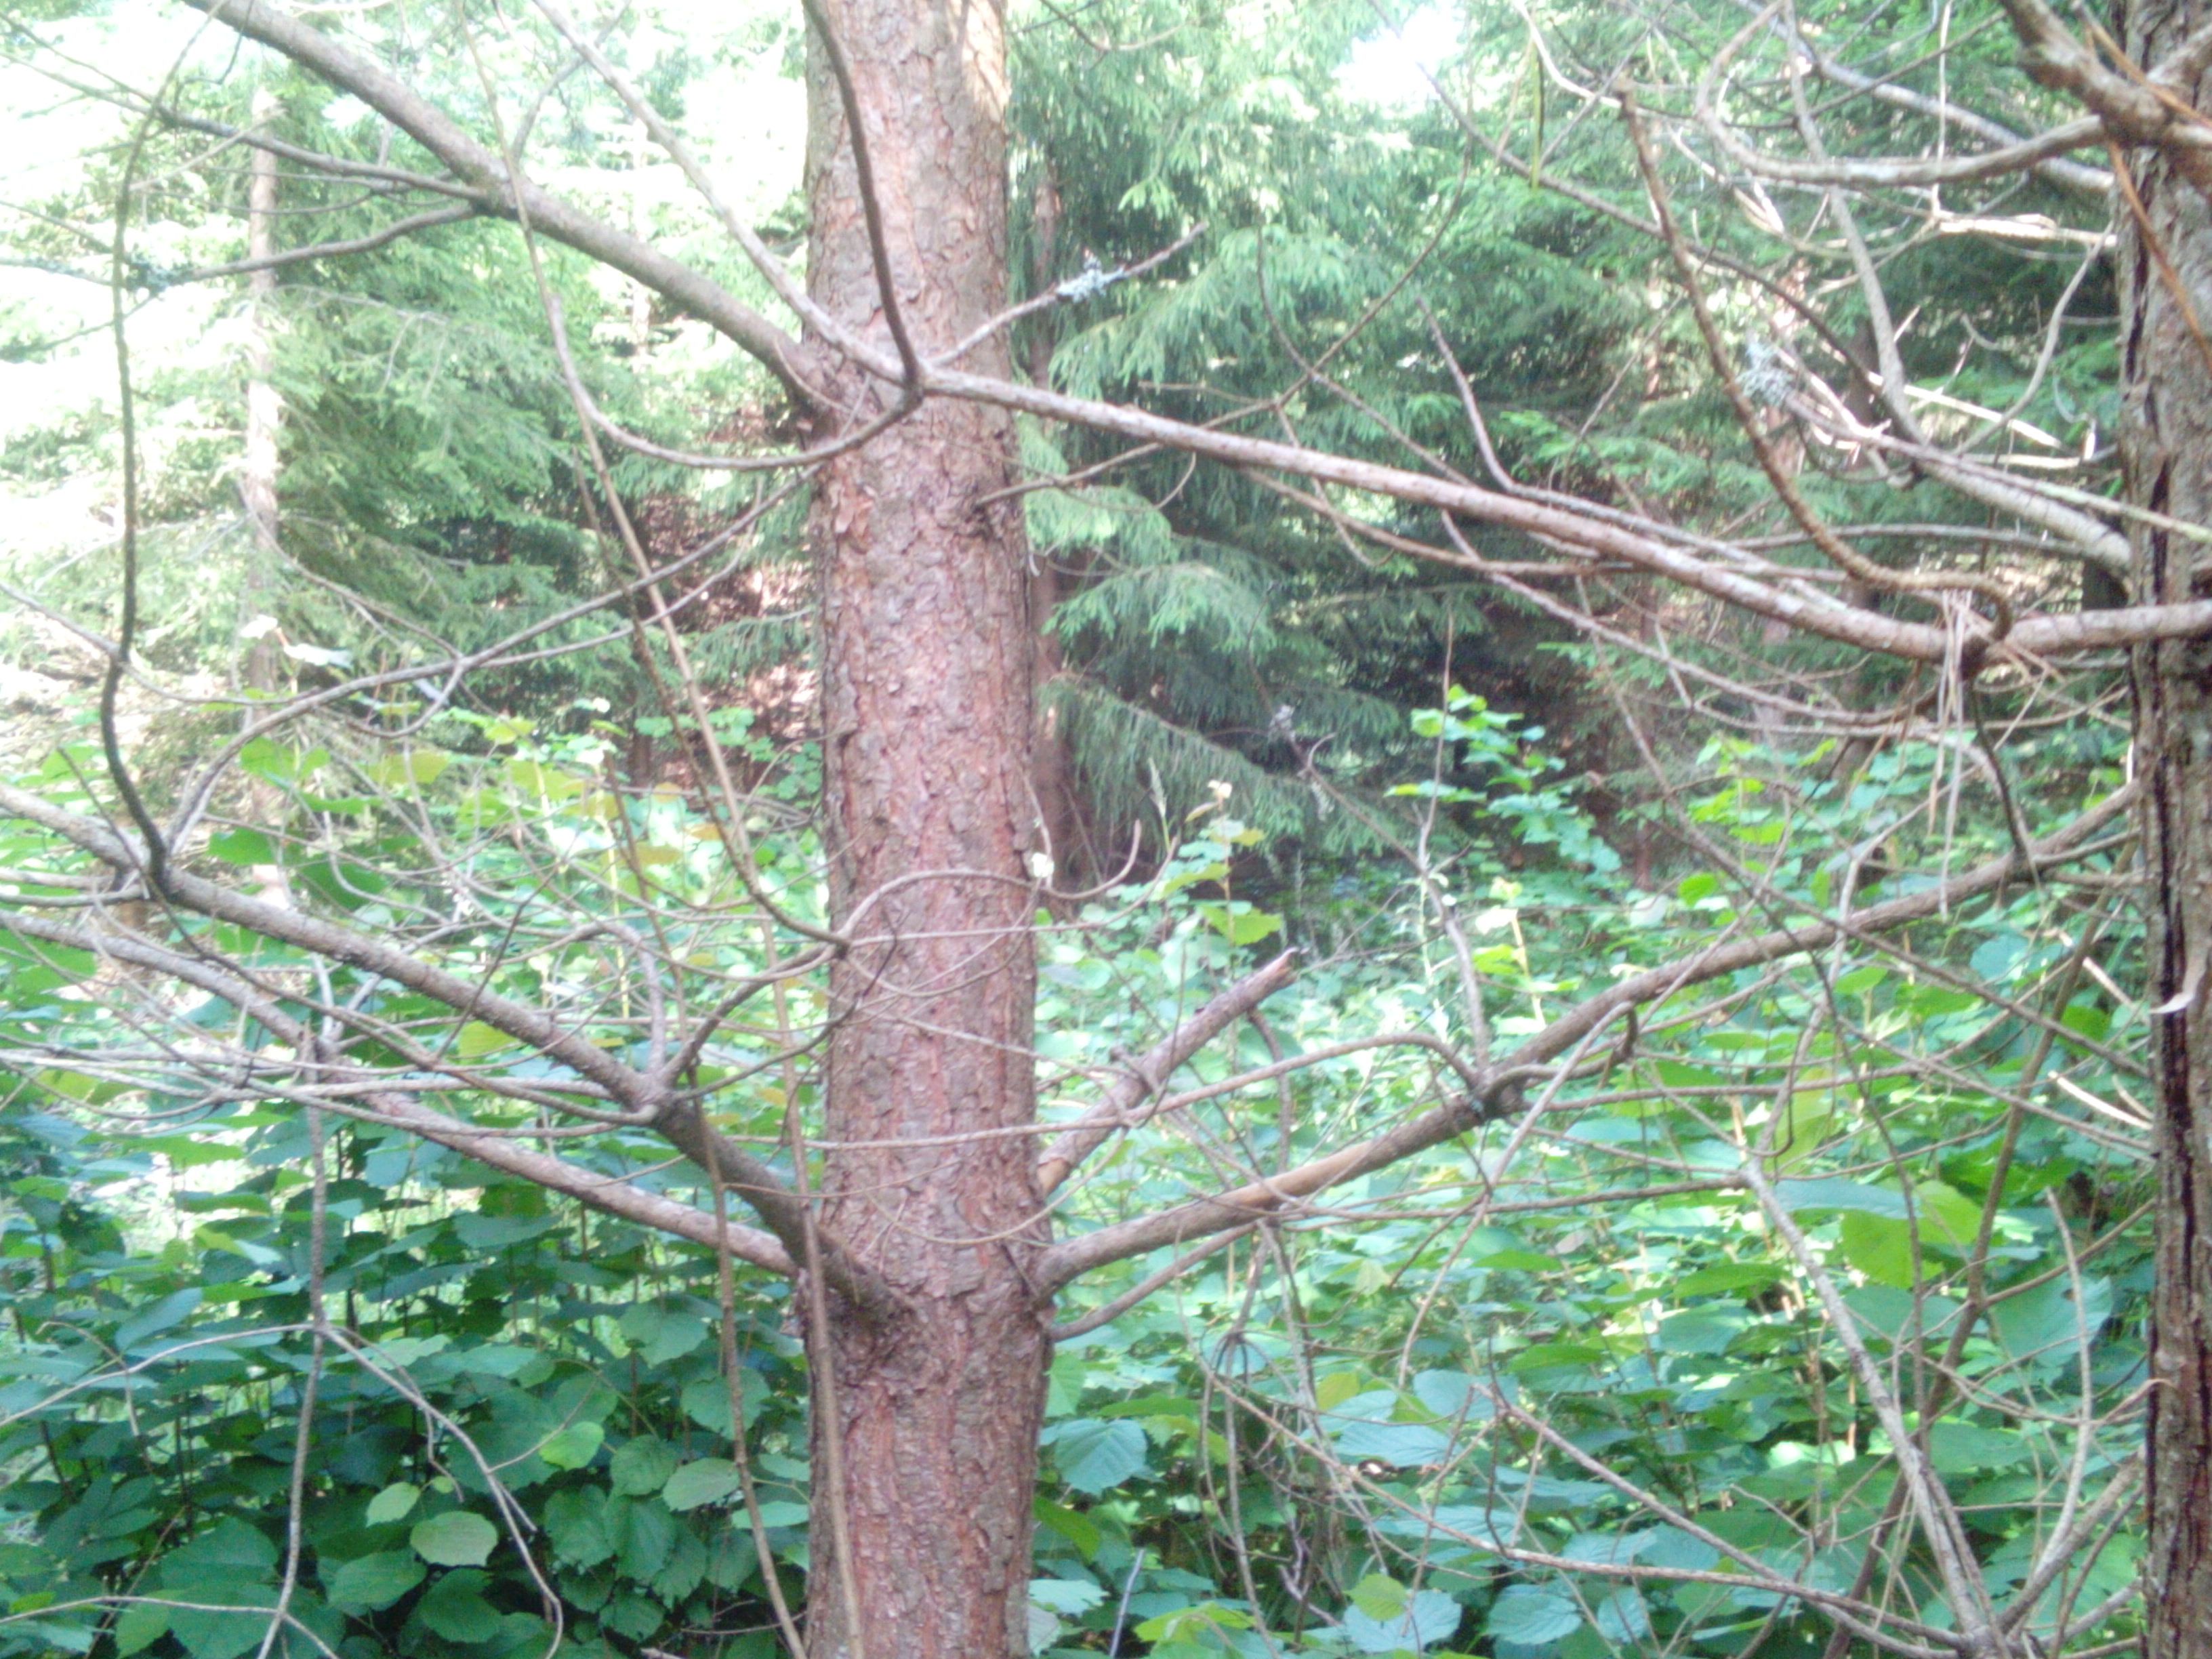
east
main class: Woodland
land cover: Spruce dominated coniferous woodland
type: hemiboreal forest and nemoral coniferous forest and mixed broadleaved-coniferous forest
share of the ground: 50 - 75 %
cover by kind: coniferous forest trees 65 %, herbaceous plants 20 %, broadleaved forest trees 15 %
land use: Forestry
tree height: > 5 m
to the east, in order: Spruce dominated coniferous woodland; Broadleaved woodland; Spruce dominated coniferous woodland; Spruce dominated mixed woodland
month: July
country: LV
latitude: 56.6140
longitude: 21.2984
